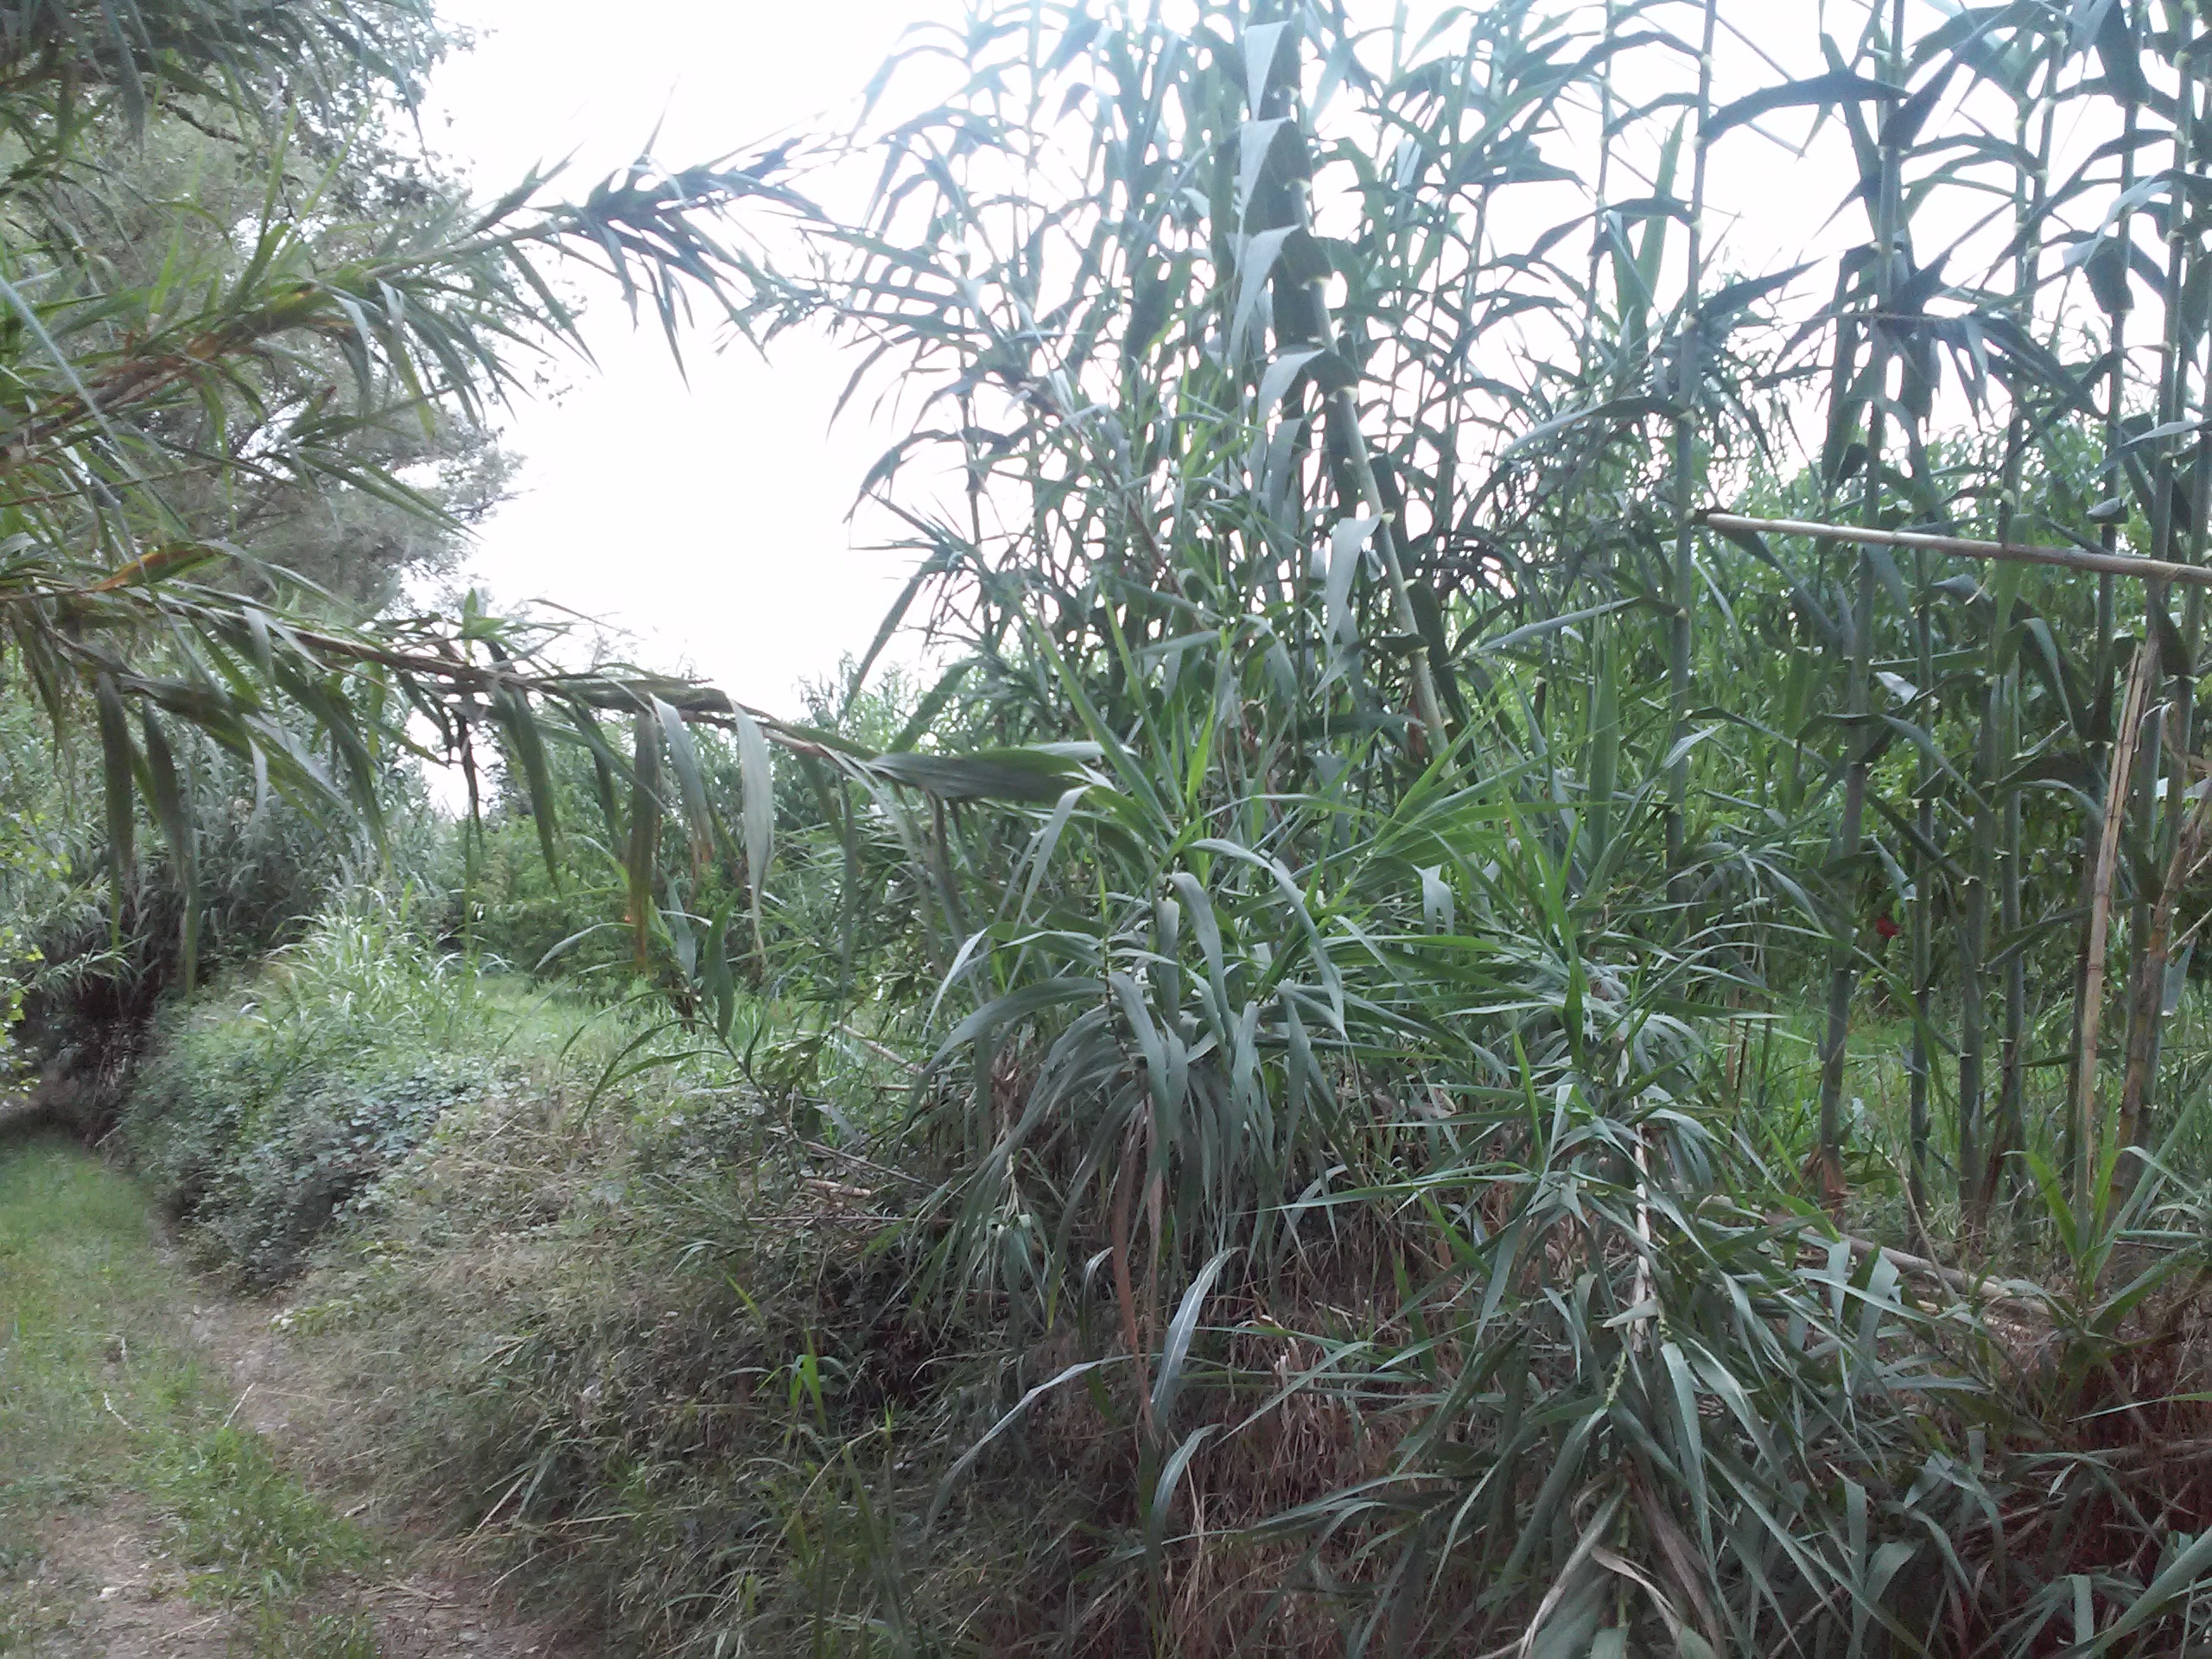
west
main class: Woodland
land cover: Broadleaved woodland
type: floodplain forest
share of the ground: 10 - 25 %
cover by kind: broadleaved forest trees 50 %, shrubs 25 %, herbaceous plants 25 %
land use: Semi-natural and natural areas not in use
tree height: < 5 m
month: July
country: ES
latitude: 41.5346
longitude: 0.5070
